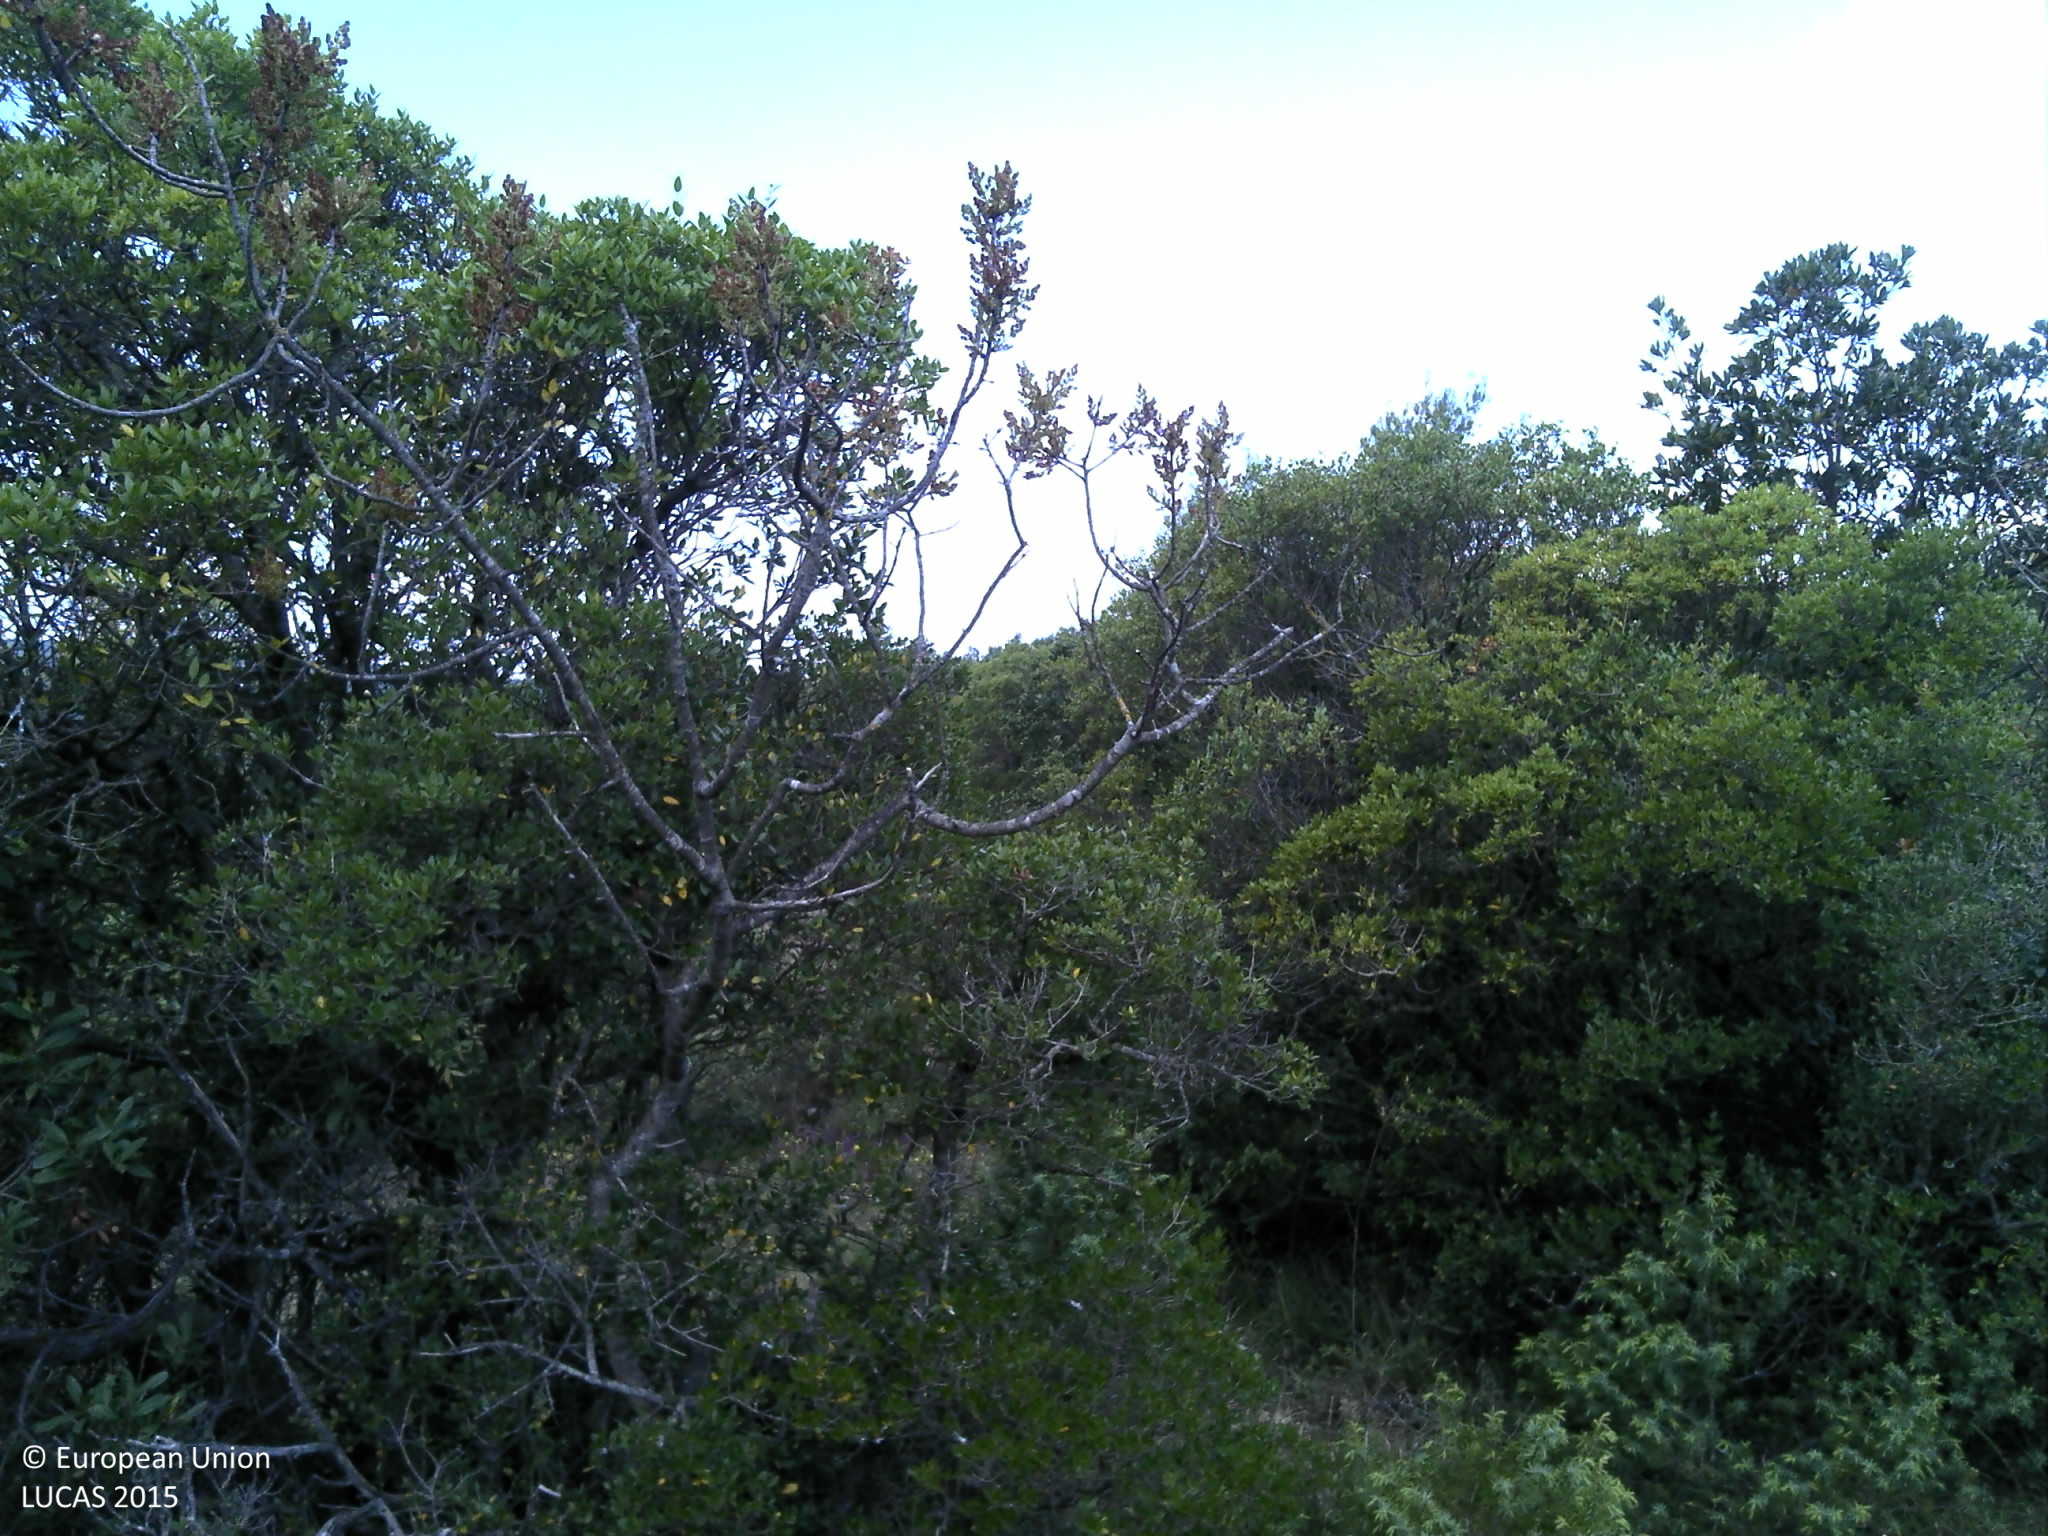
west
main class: Woodland
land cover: Pine dominated coniferous woodland
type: coniferous forest of the mediterranean region
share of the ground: 50 - 75 %
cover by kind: coniferous forest trees 50 %, shrubs 20 %, herbaceous plants 20 %, broadleaved forest trees 5 %, unconsolidated bare surface 5 %
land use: Semi-natural and natural areas not in use
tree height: > 5 m
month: April
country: HR
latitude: 43.7270
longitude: 15.9623
